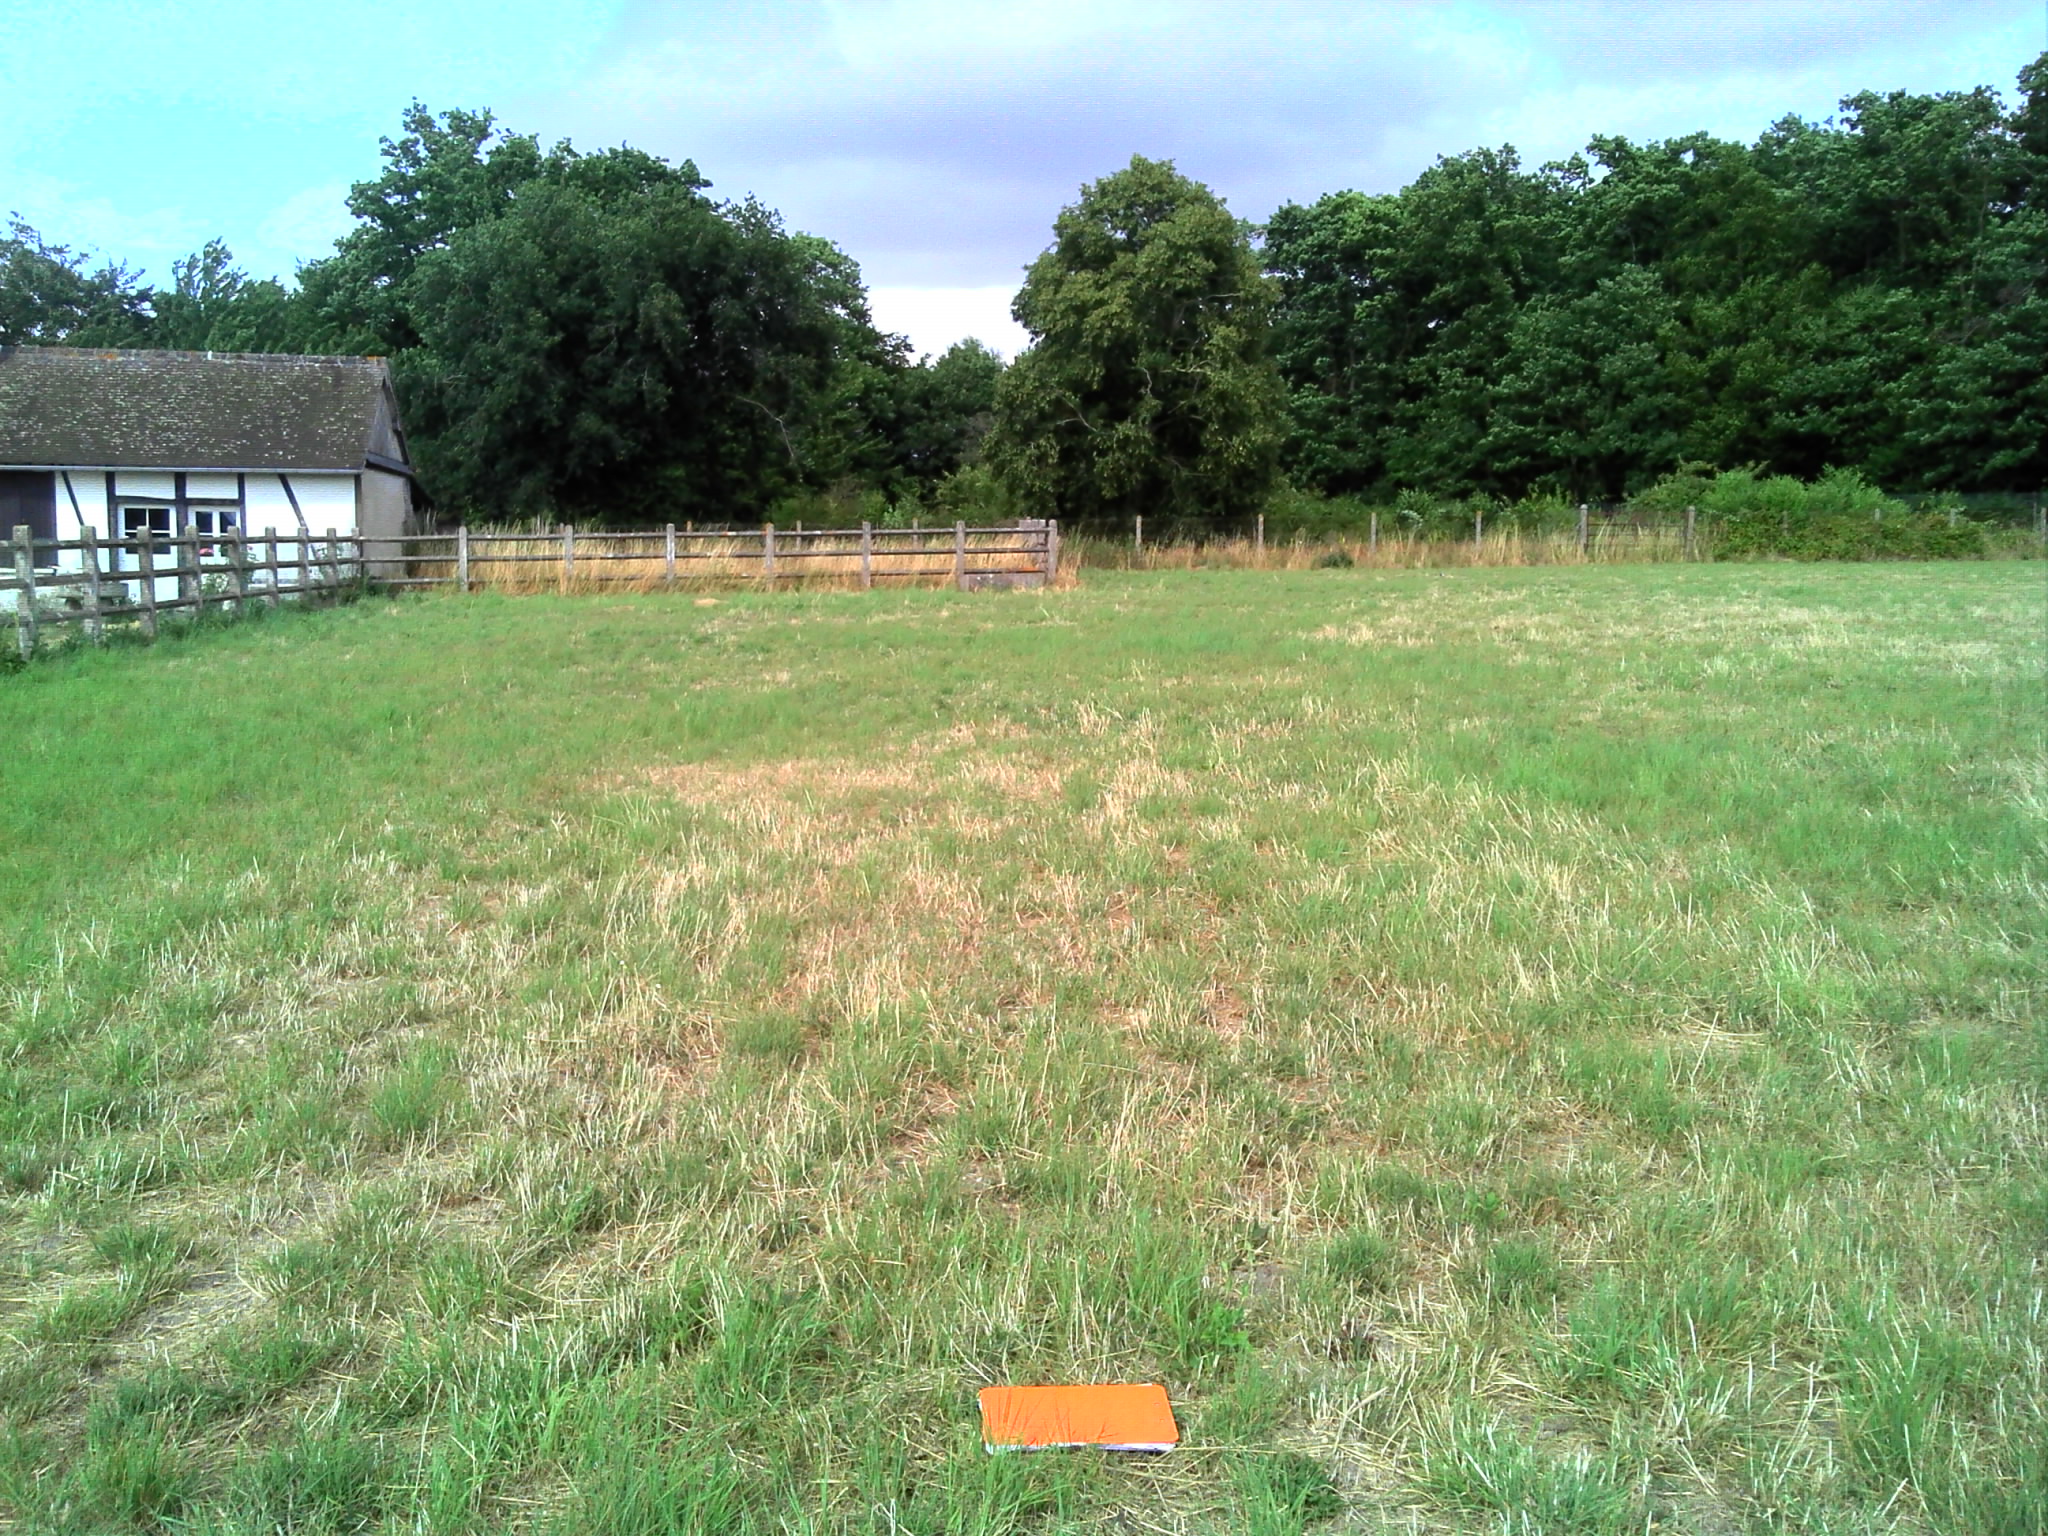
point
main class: Grassland
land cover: Grassland without tree/shrub cover
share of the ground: > 75 %
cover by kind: herbaceous plants 100 %
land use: Agriculture (excluding fallow land and kitchen gardens)
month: July
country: FR
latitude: 48.9325
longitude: 1.1204
